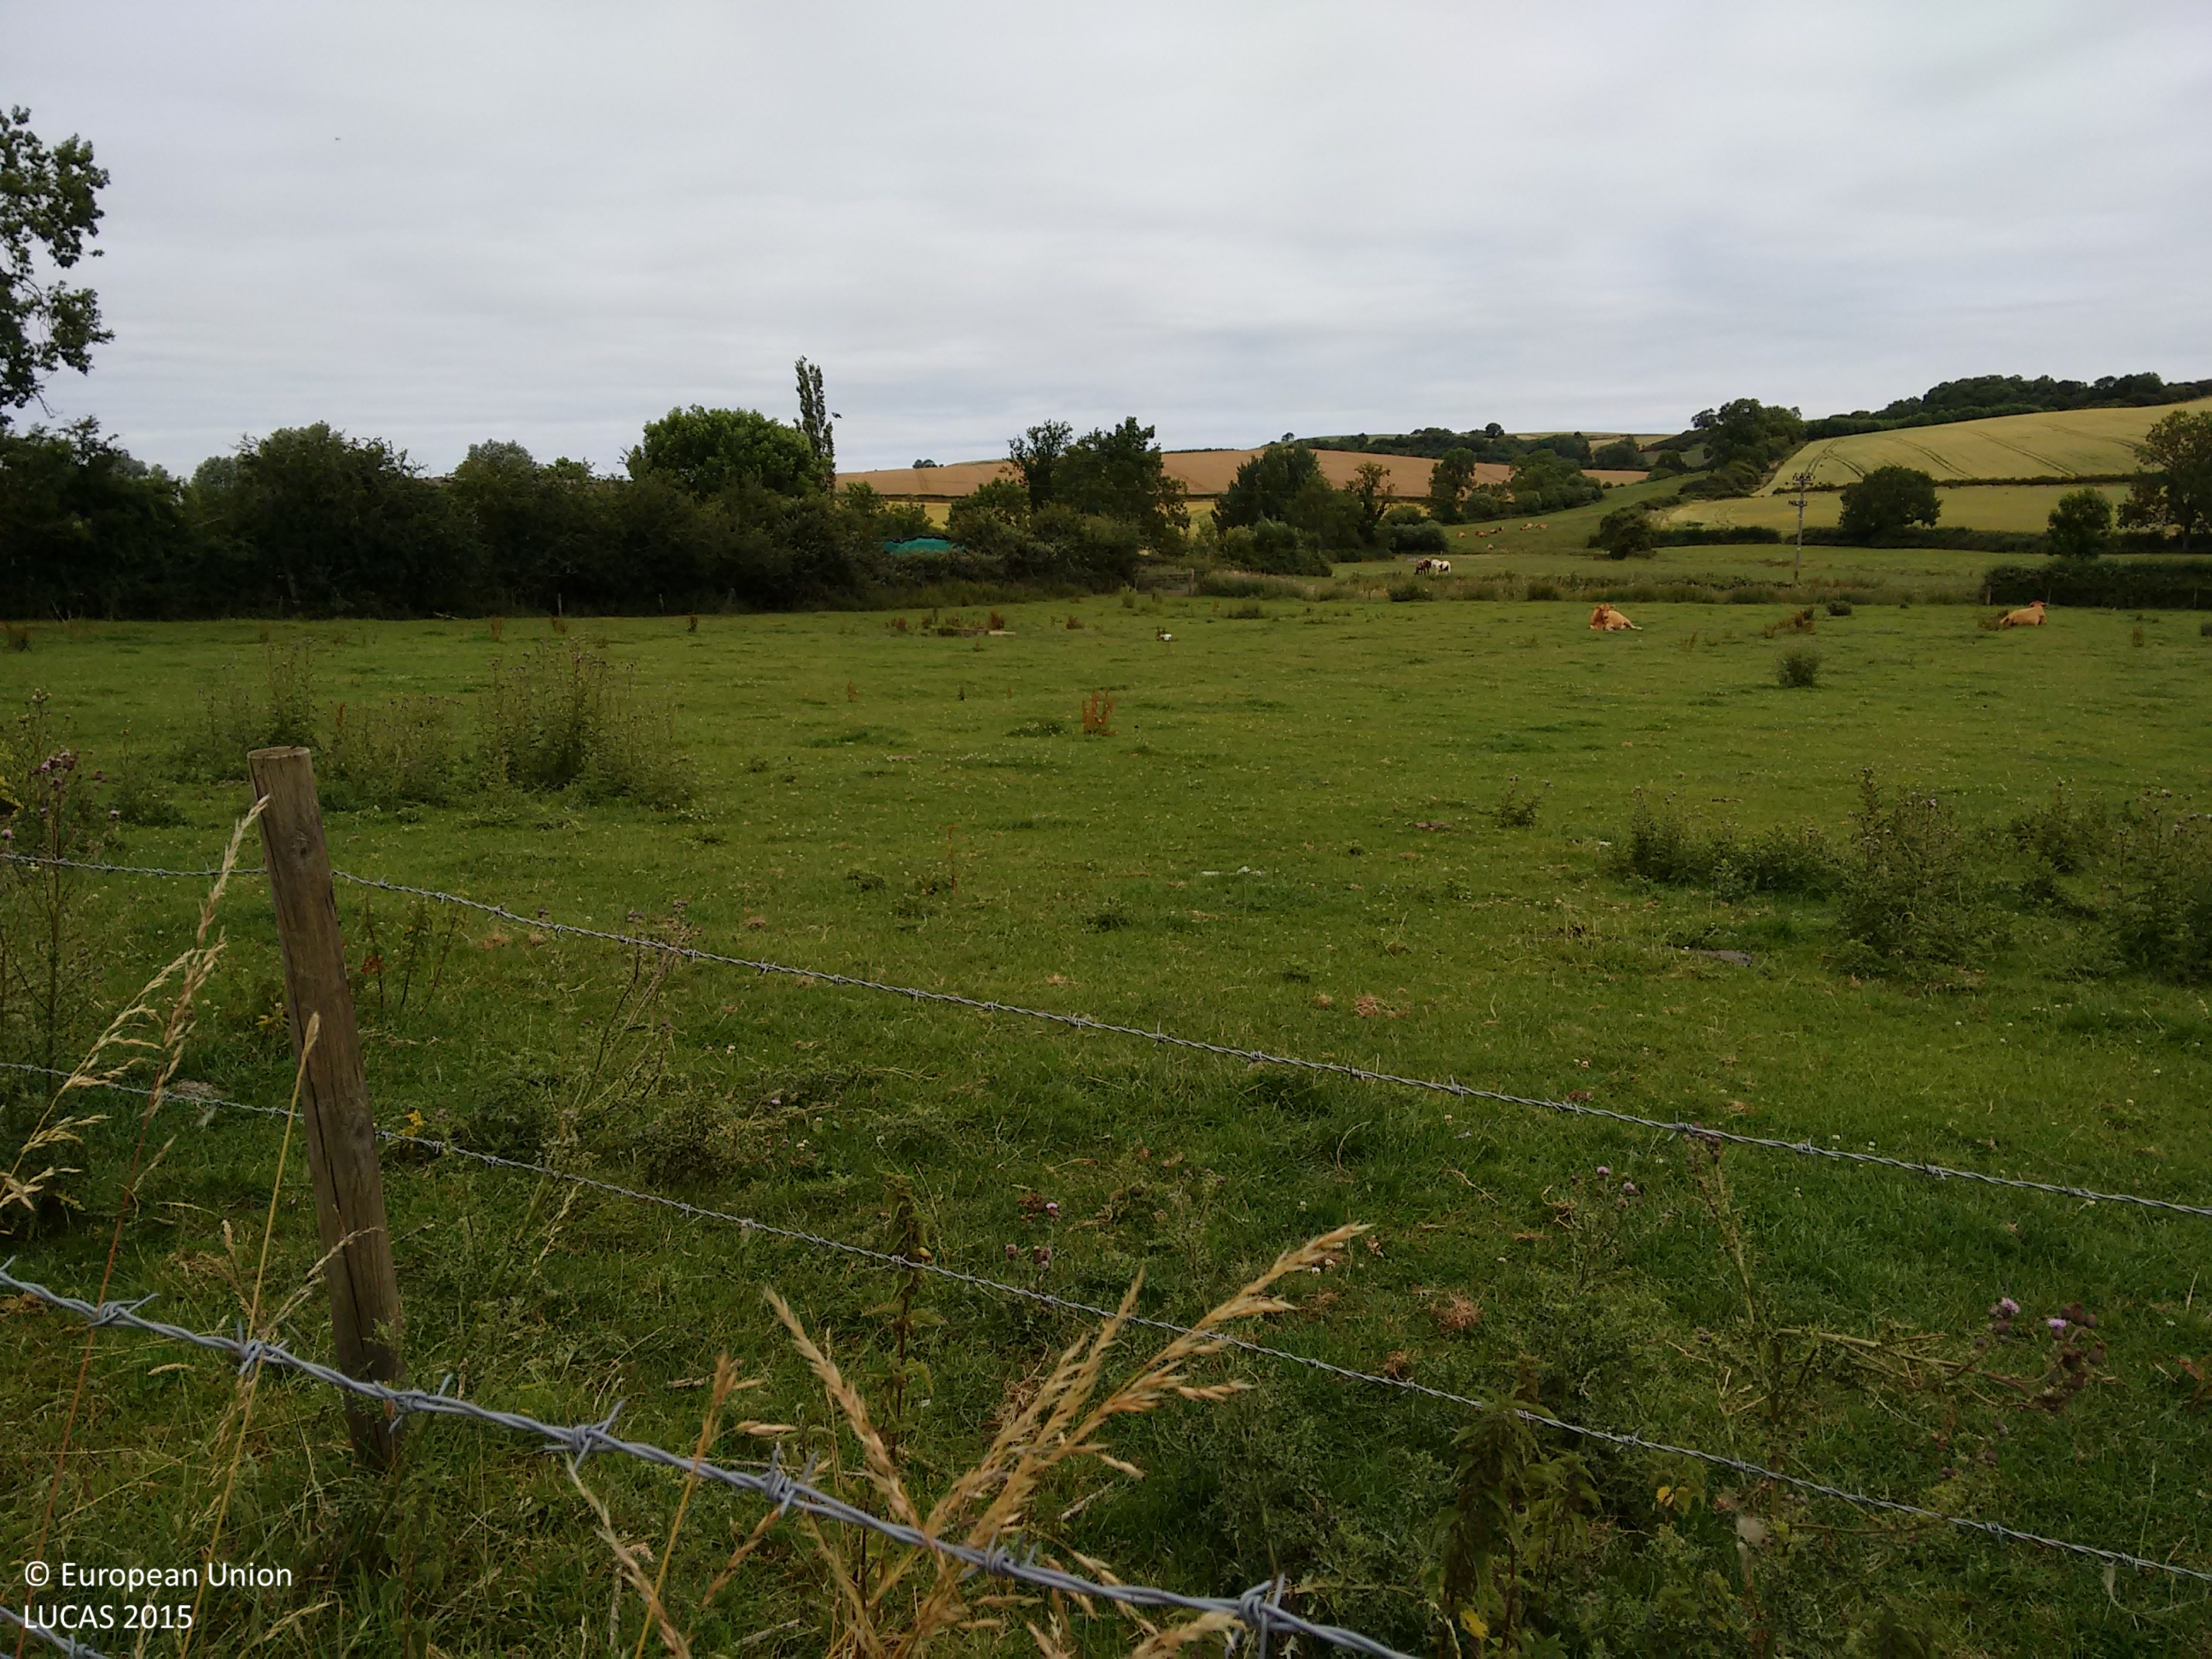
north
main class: Grassland
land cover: Grassland without tree/shrub cover
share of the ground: > 75 %
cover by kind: herbaceous plants 100 %
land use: Agriculture (excluding fallow land and kitchen gardens)
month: July
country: GB
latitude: 52.5266
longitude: -0.9062
